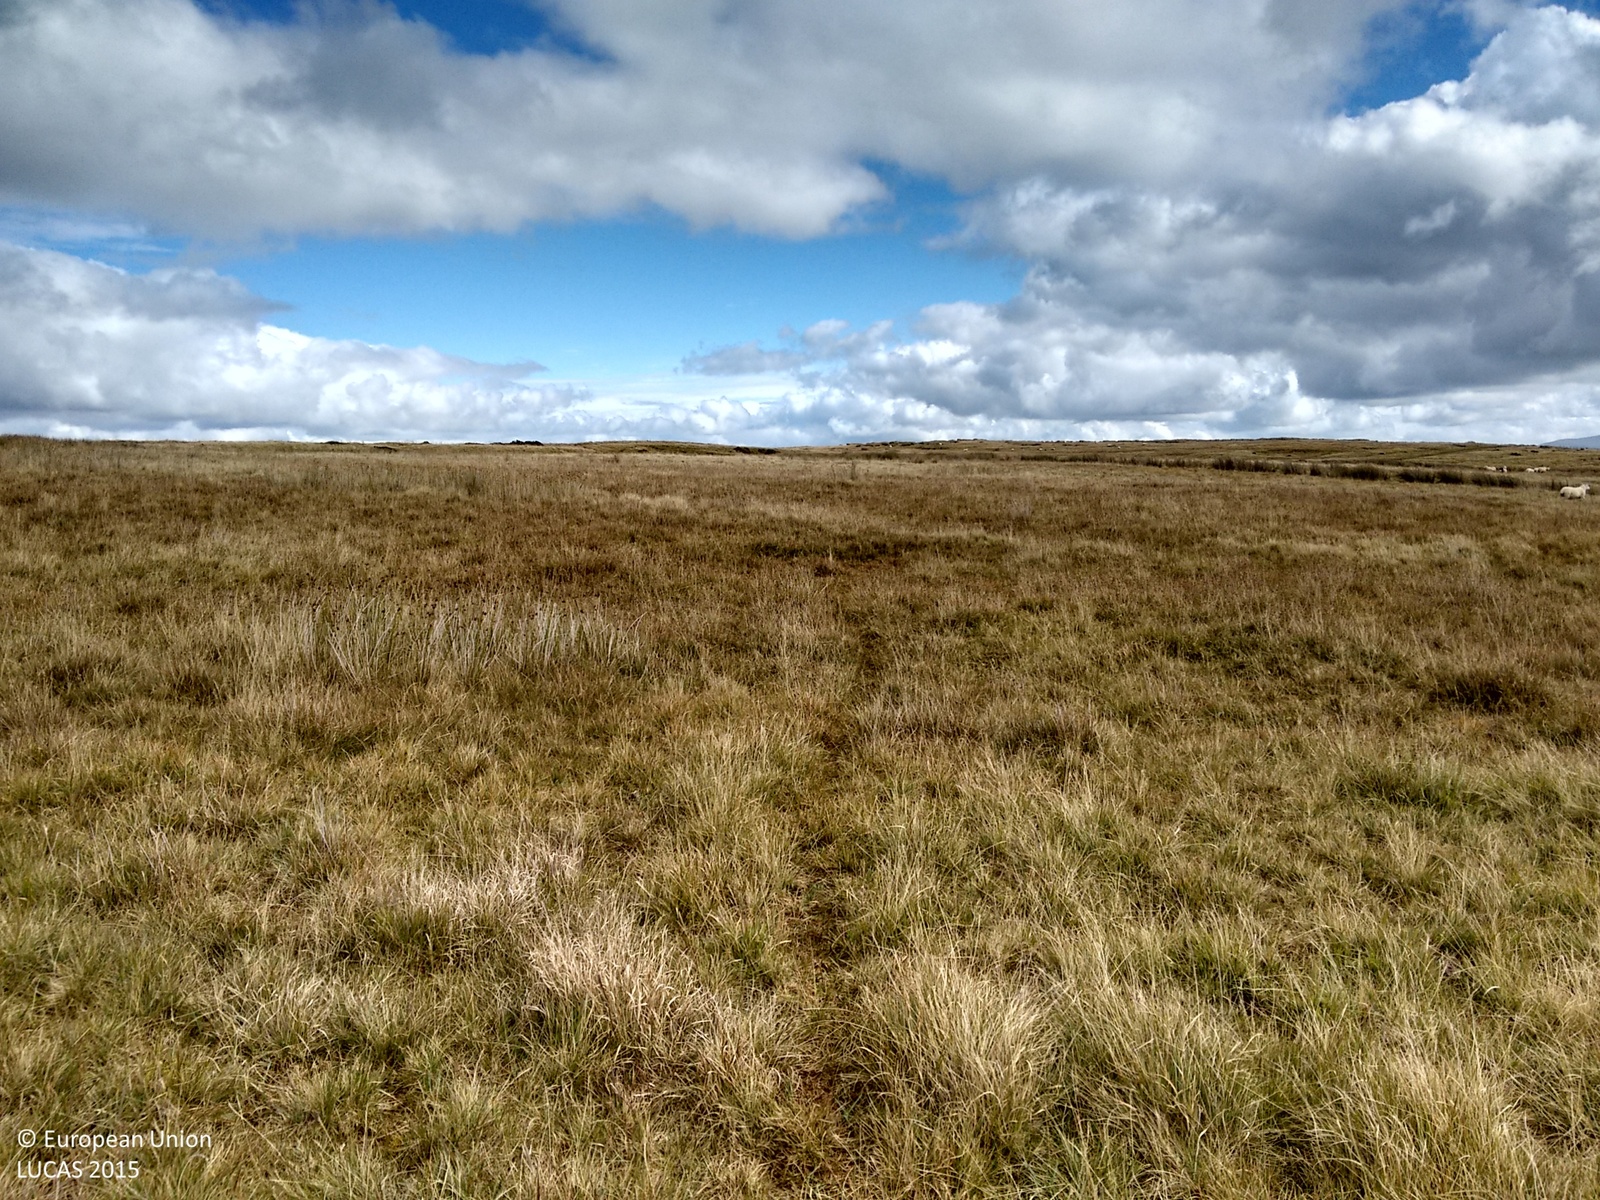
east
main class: Grassland
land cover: Grassland without tree/shrub cover
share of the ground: > 75 %
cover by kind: herbaceous plants 100 %
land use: Agriculture (excluding fallow land and kitchen gardens)
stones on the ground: < 10 %
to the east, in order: Grassland without tree/shrub cover; Tracks; Grassland without tree/shrub cover
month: September
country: GB
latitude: 51.9618
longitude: -3.6958
